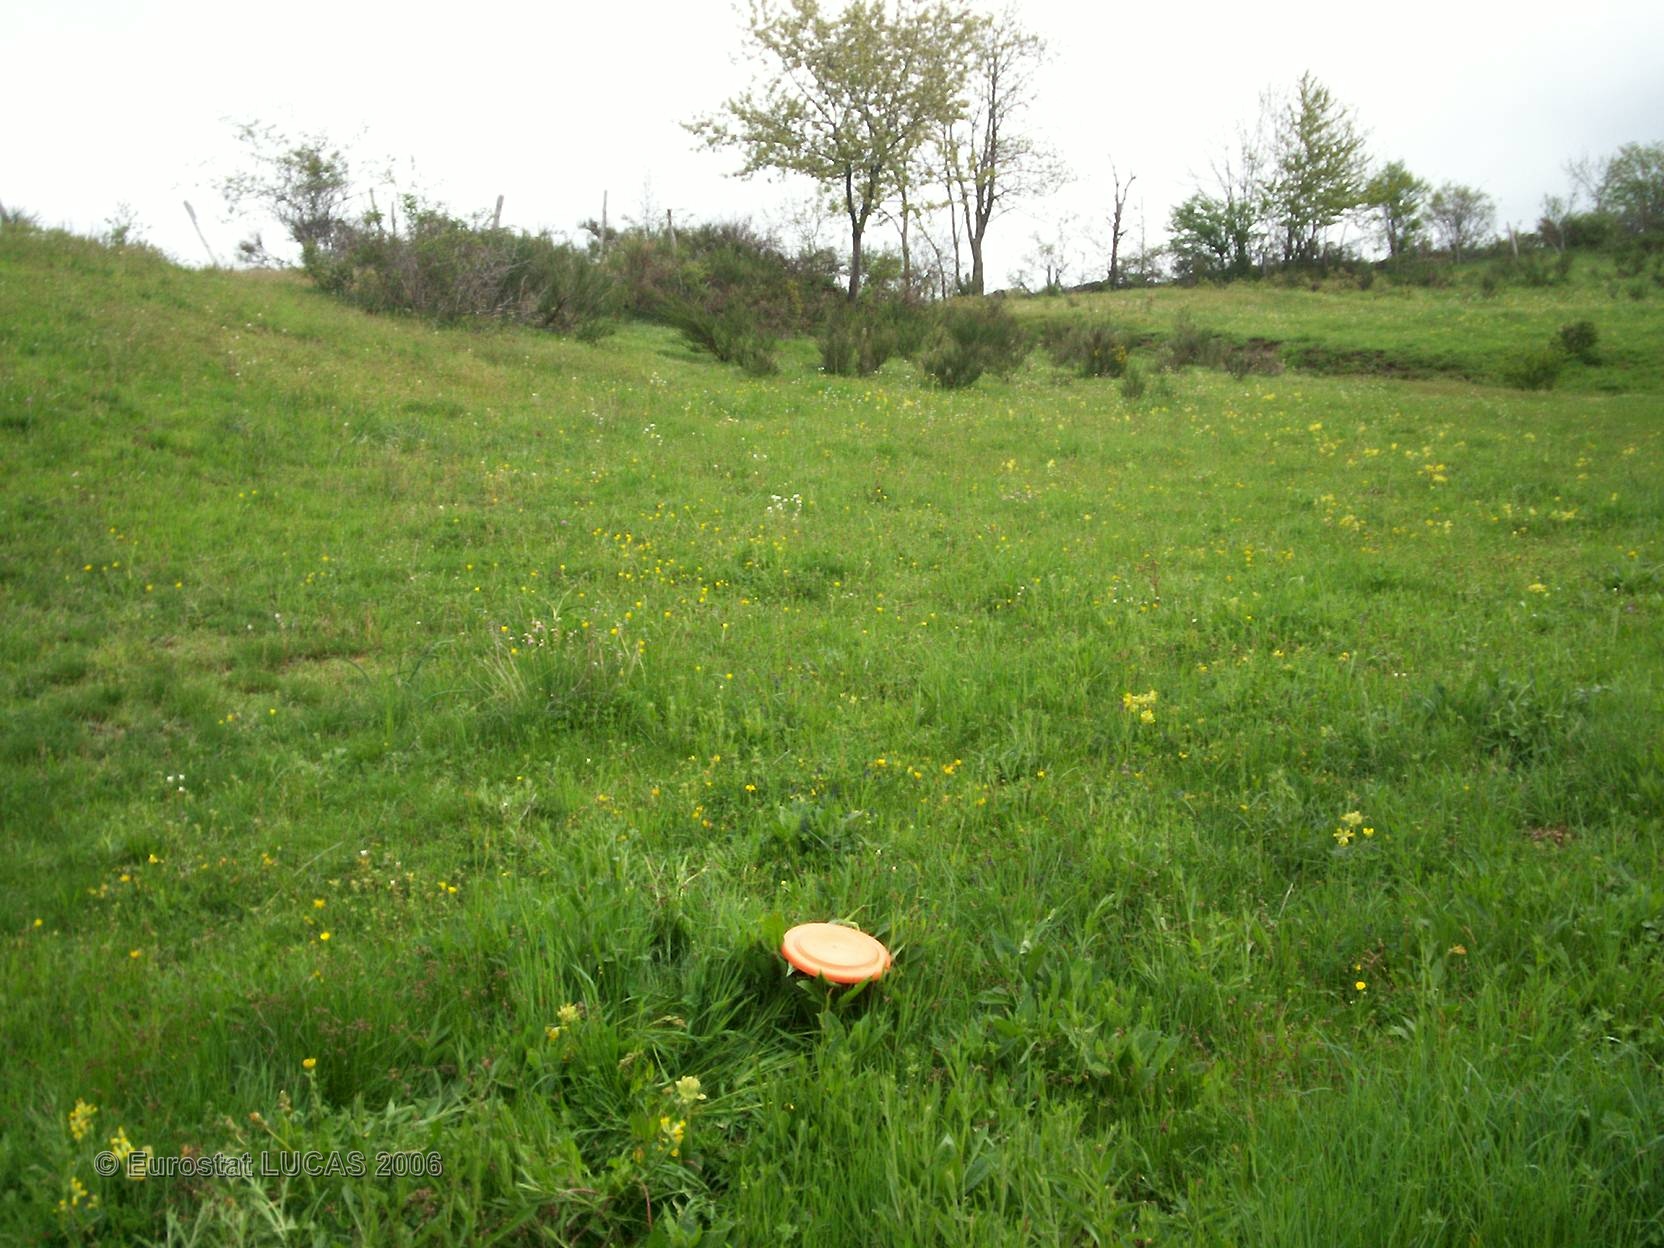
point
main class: Grassland
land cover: Grassland without tree/shrub cover
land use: Agriculture (excluding fallow land and kitchen gardens)
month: May
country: FR
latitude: 45.2154
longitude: 3.2405
